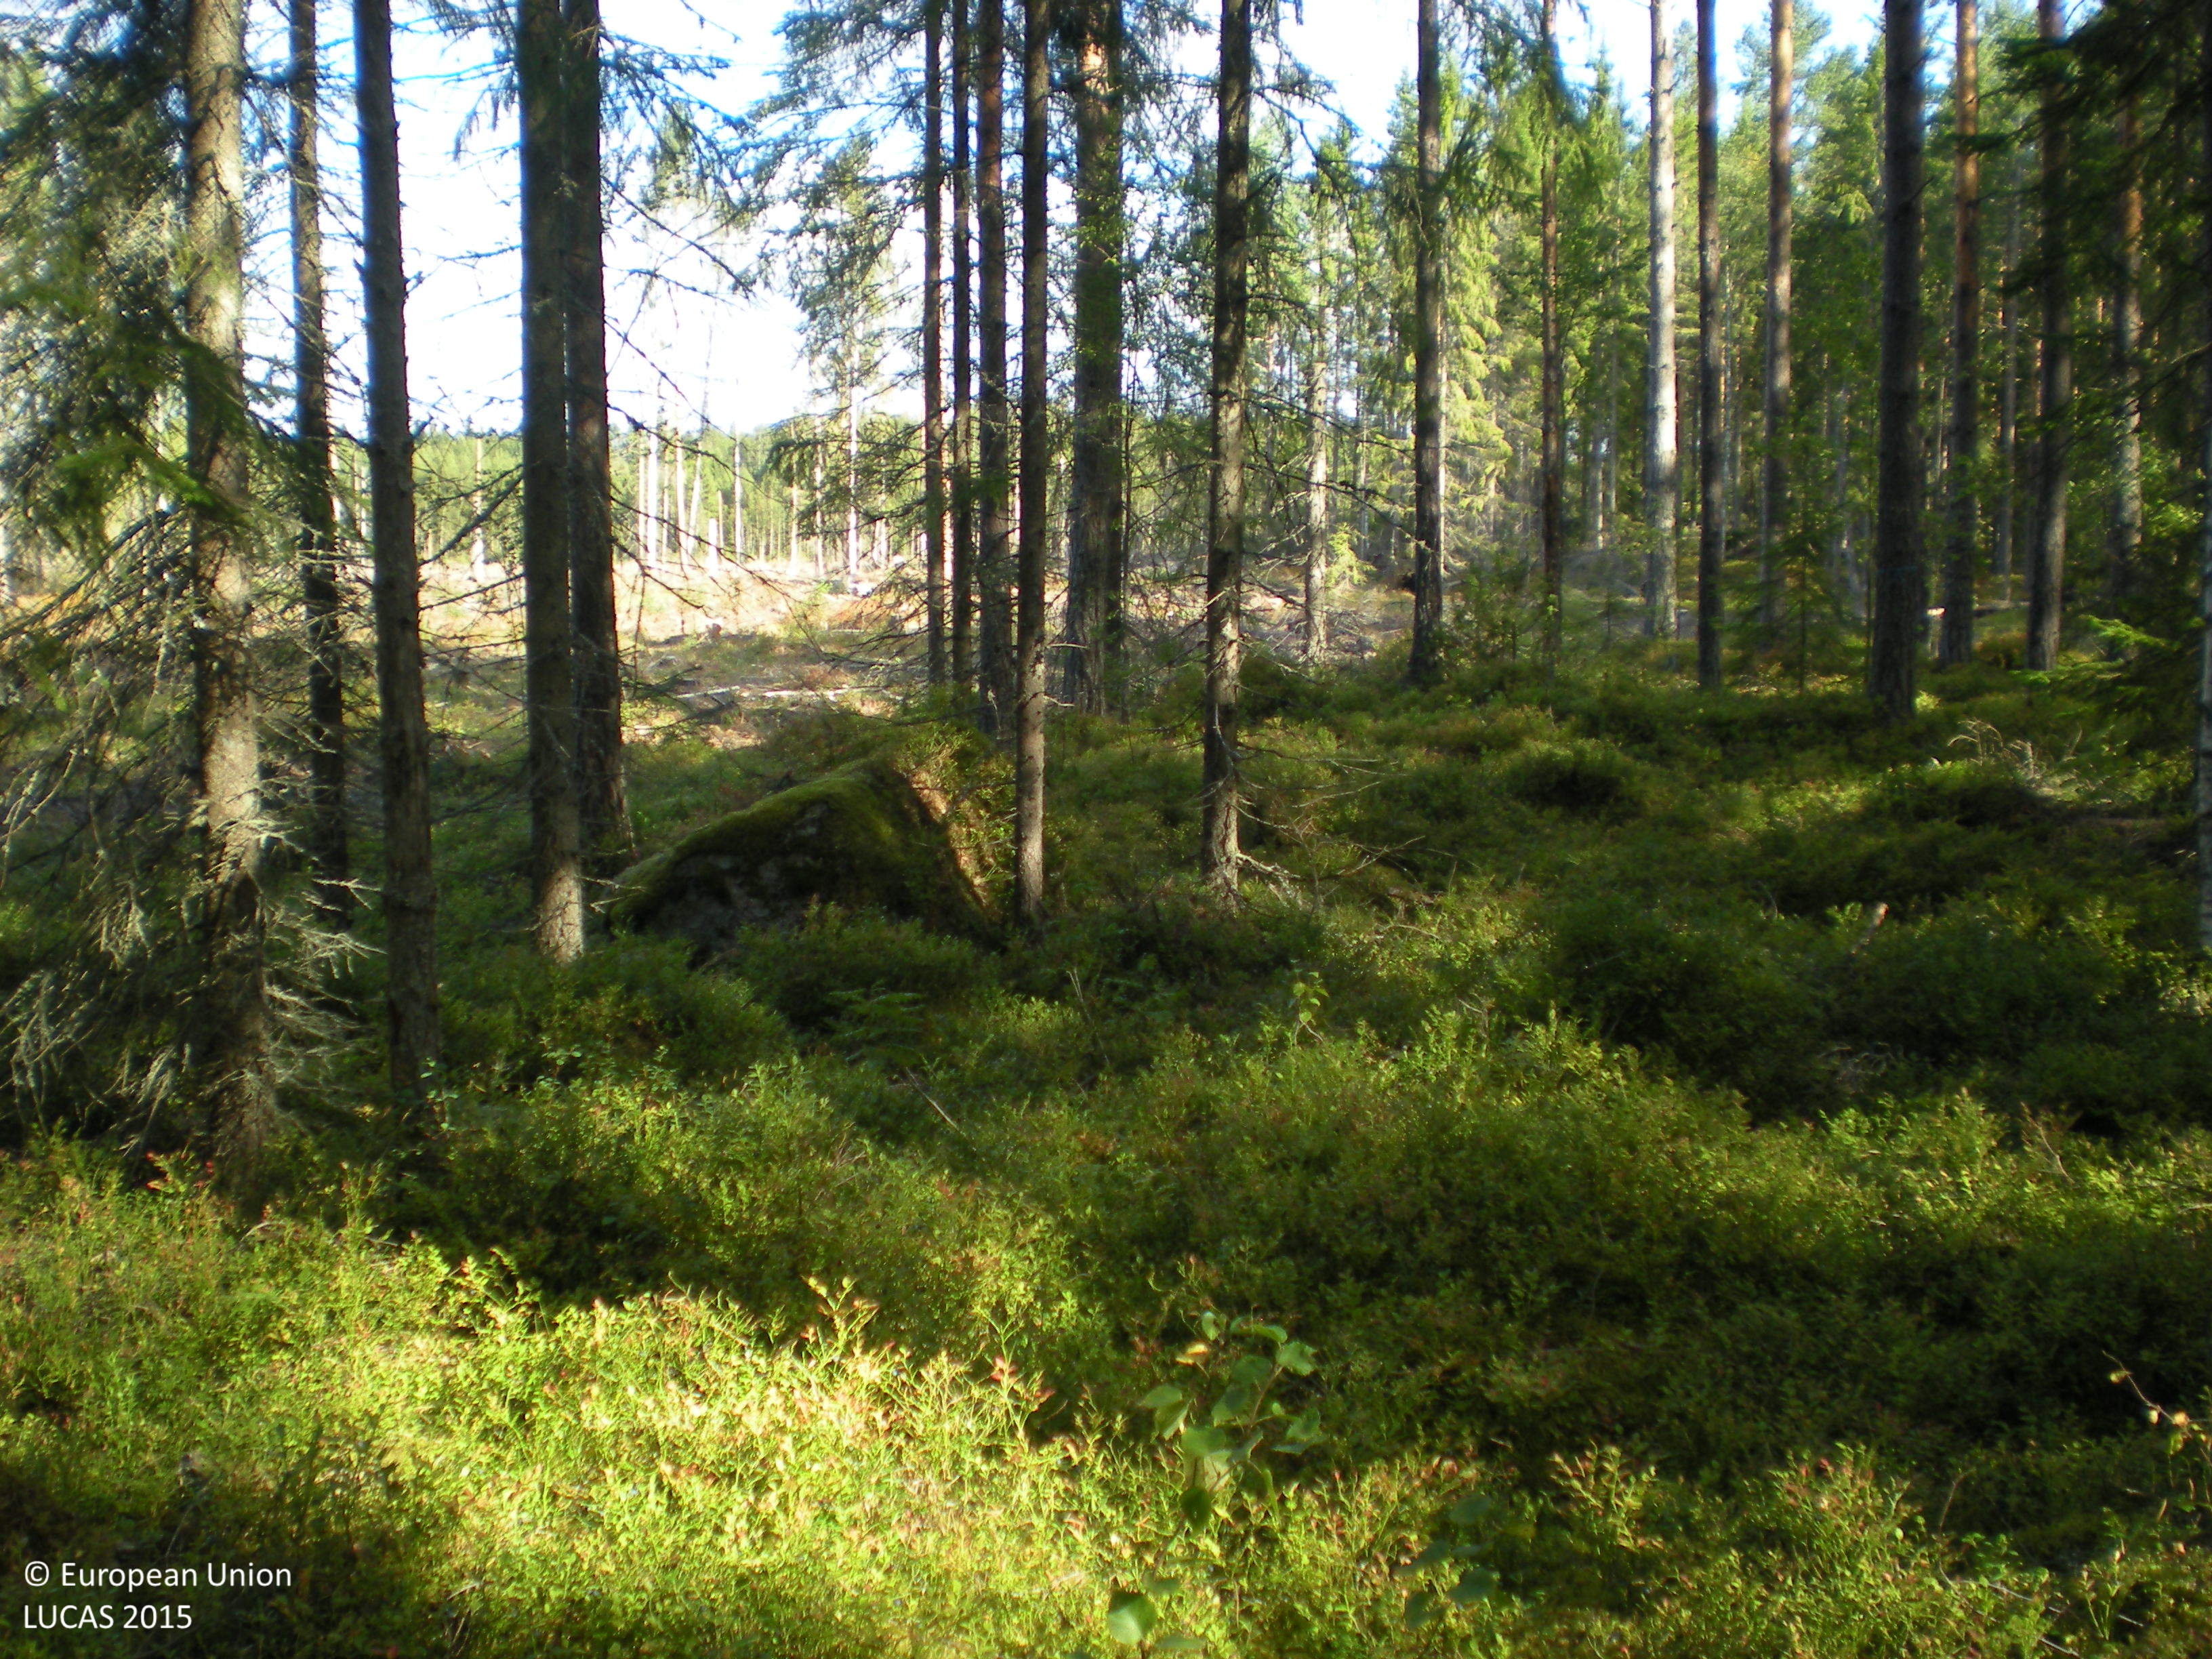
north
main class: Woodland
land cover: Other coniferous woodland
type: boreal forest
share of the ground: 50 - 75 %
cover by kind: coniferous forest trees 70 %, shrubs 20 %, broadleaved forest trees 5 %, lichens and mosses 5 %
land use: Forestry
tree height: > 5 m
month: August
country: SE
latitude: 60.4379
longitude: 17.0584
